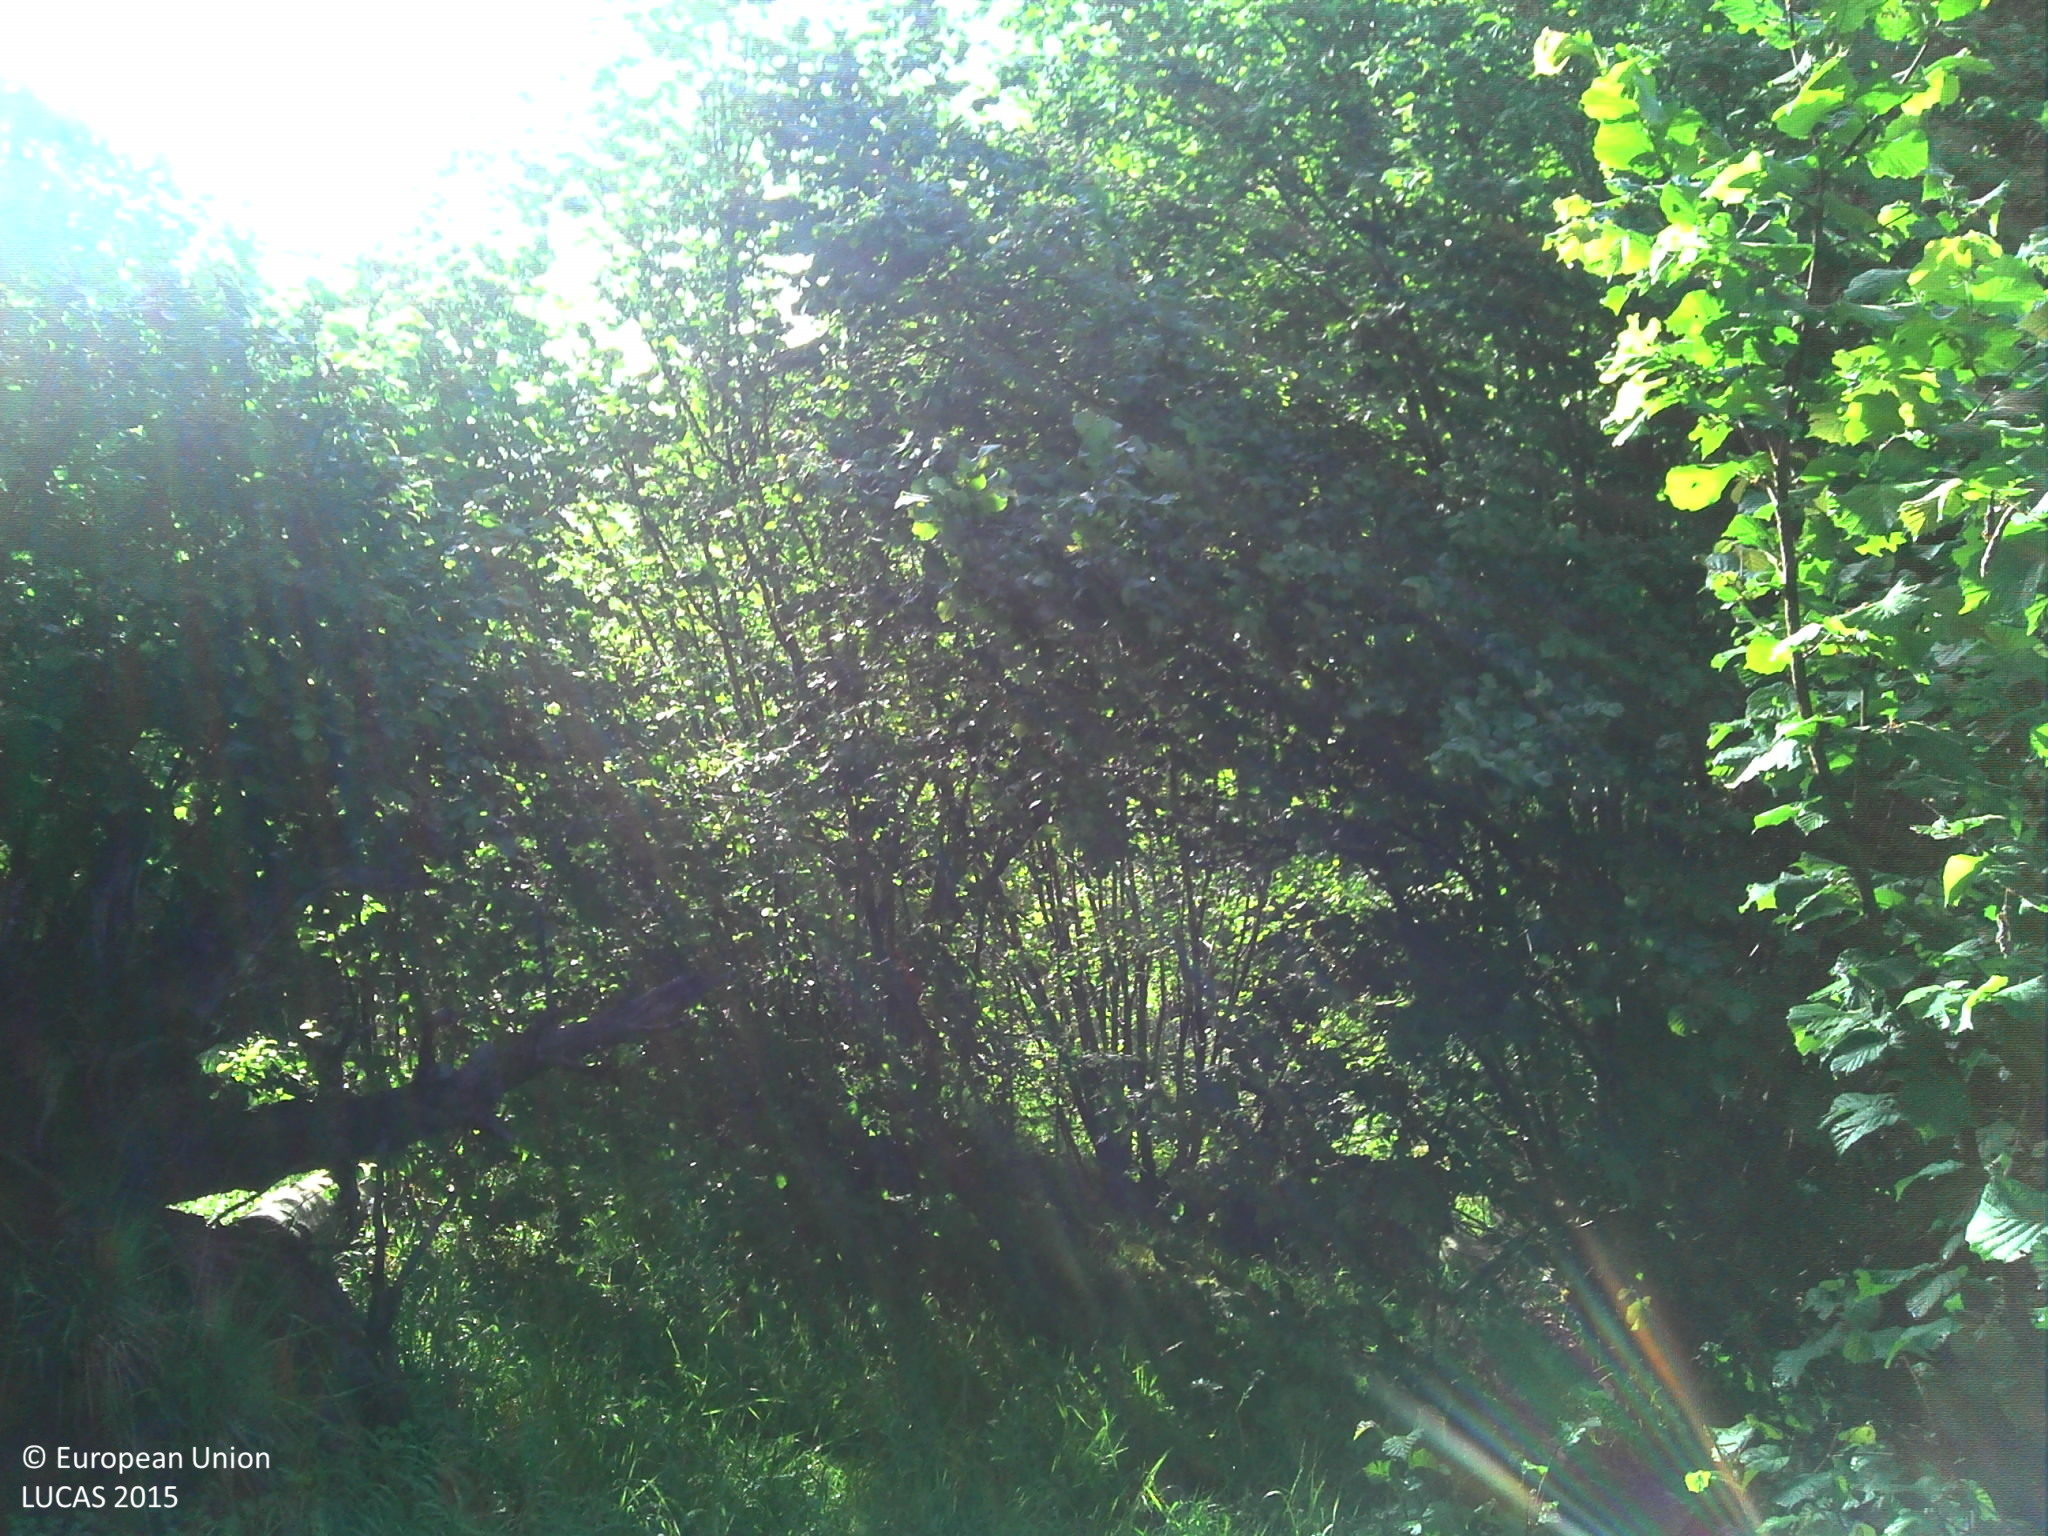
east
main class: Woodland
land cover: Pine dominated mixed woodland
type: alpine coniferous forest
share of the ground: > 75 %
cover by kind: broadleaved forest trees 50 %, coniferous forest trees 20 %, herbaceous plants 20 %, shrubs 10 %
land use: Forestry
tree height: > 5 m
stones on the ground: 10 - 25 %
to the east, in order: Pine dominated mixed woodland; Tracks; Grass margins; Pine dominated mixed woodland; Fences; Grassland with sparse tree/shrub cover; Grassland without tree/shrub cover; Grassland with sparse tree/shrub cover
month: June
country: FR
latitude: 45.1757
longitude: 2.9135
